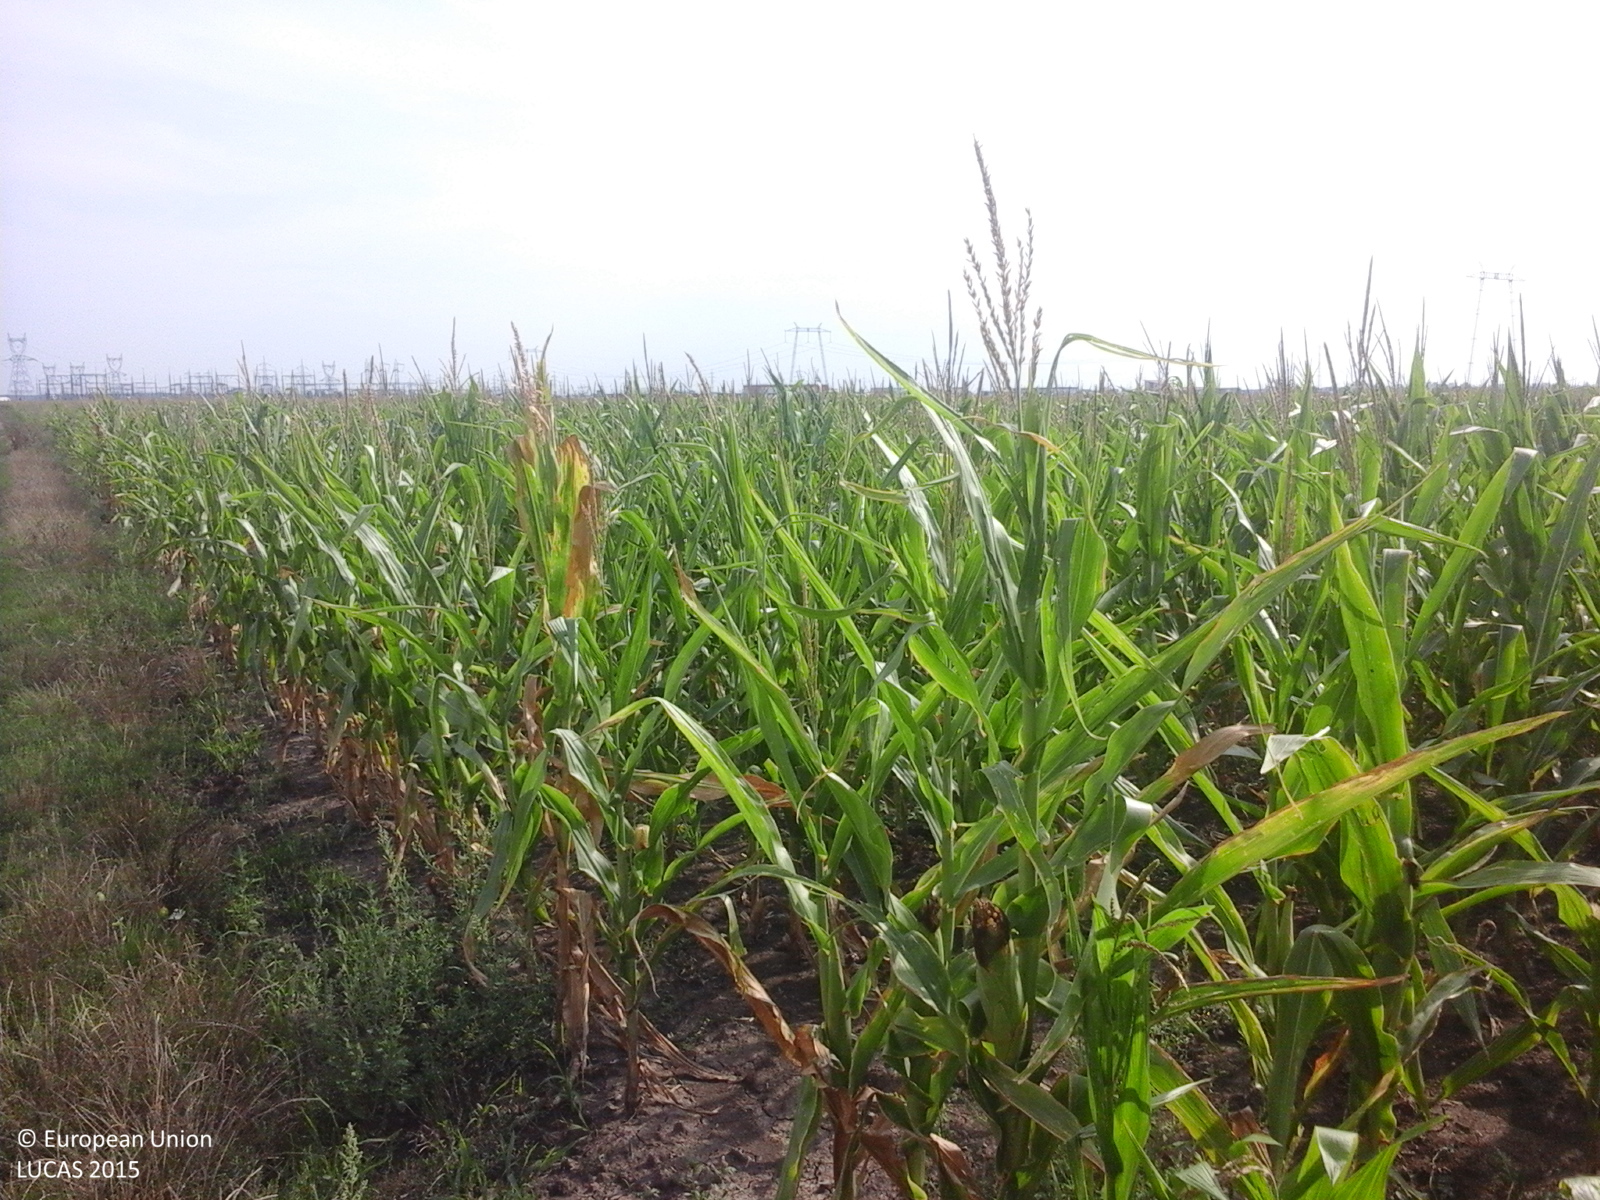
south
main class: Cropland
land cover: Maize
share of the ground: > 75 %
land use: Agriculture (excluding fallow land and kitchen gardens)
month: August
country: RO
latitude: 46.1970
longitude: 21.3733
